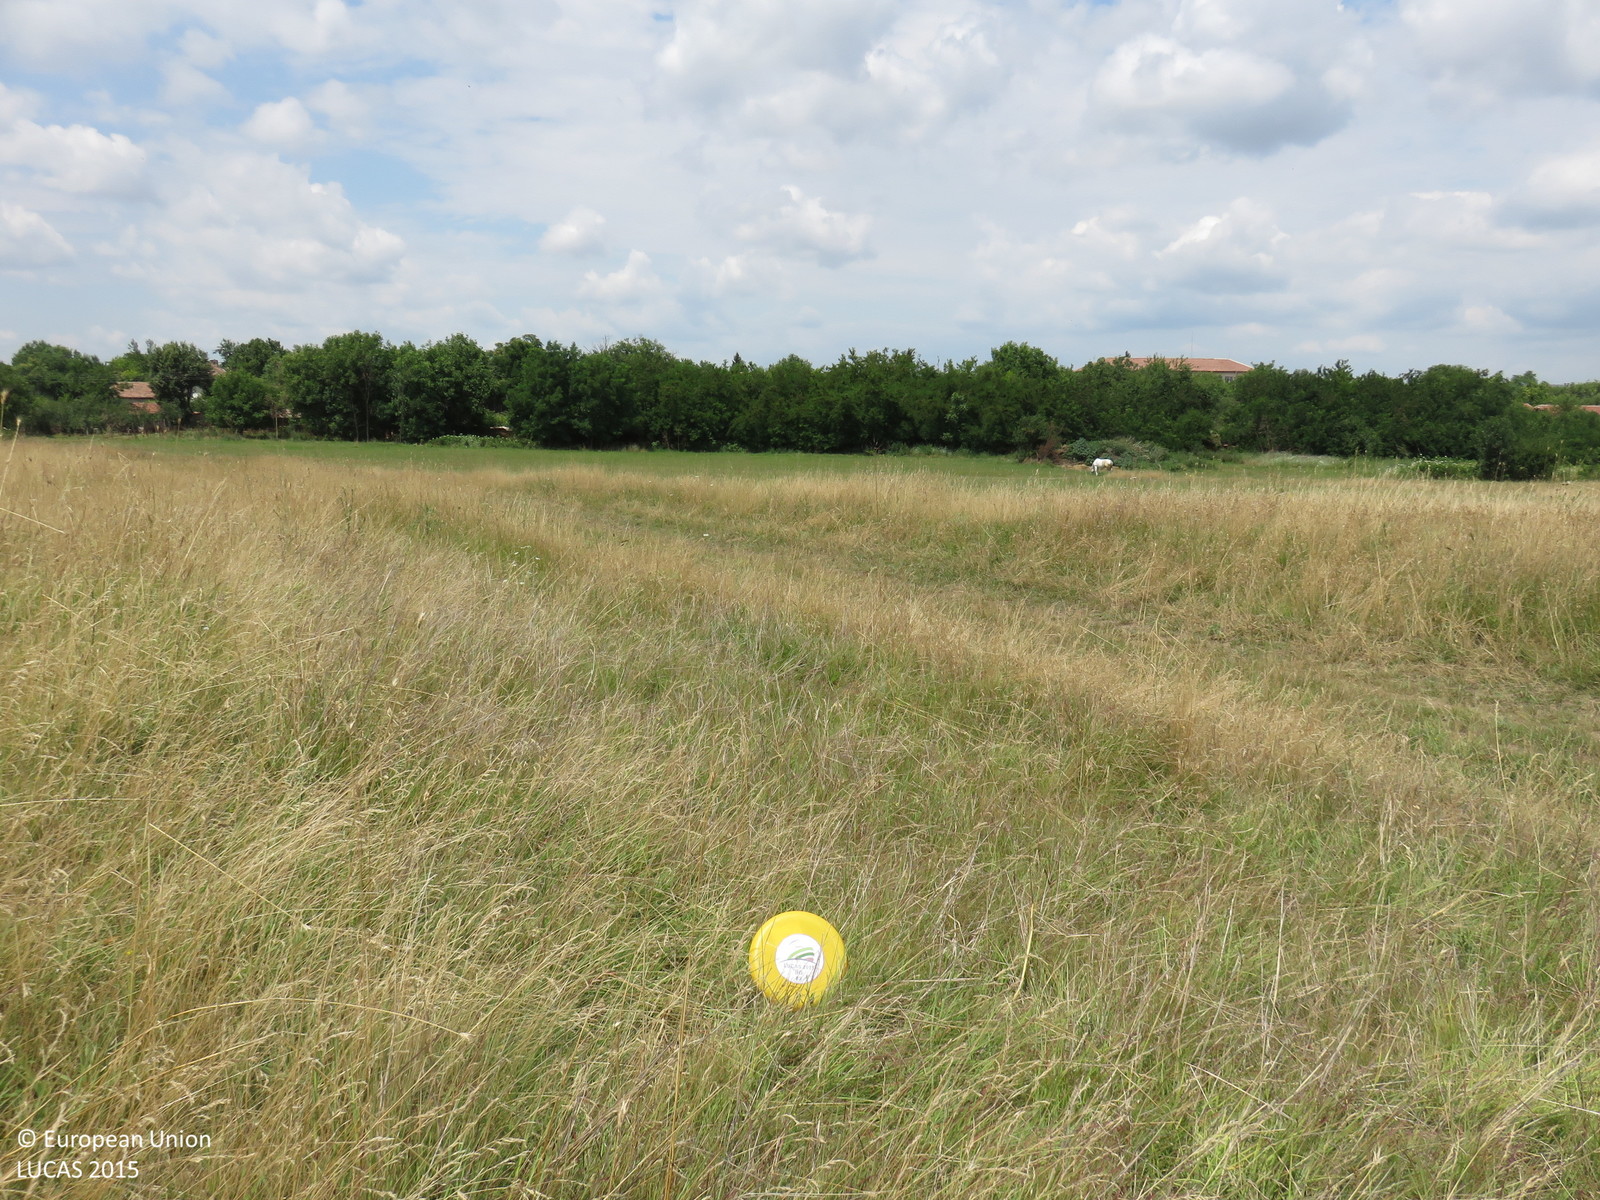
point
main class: Grassland
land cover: Grassland without tree/shrub cover
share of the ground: > 75 %
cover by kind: herbaceous plants 100 %
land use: Agriculture (excluding fallow land and kitchen gardens)
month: June
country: BG
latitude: 43.4318
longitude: 24.9053
